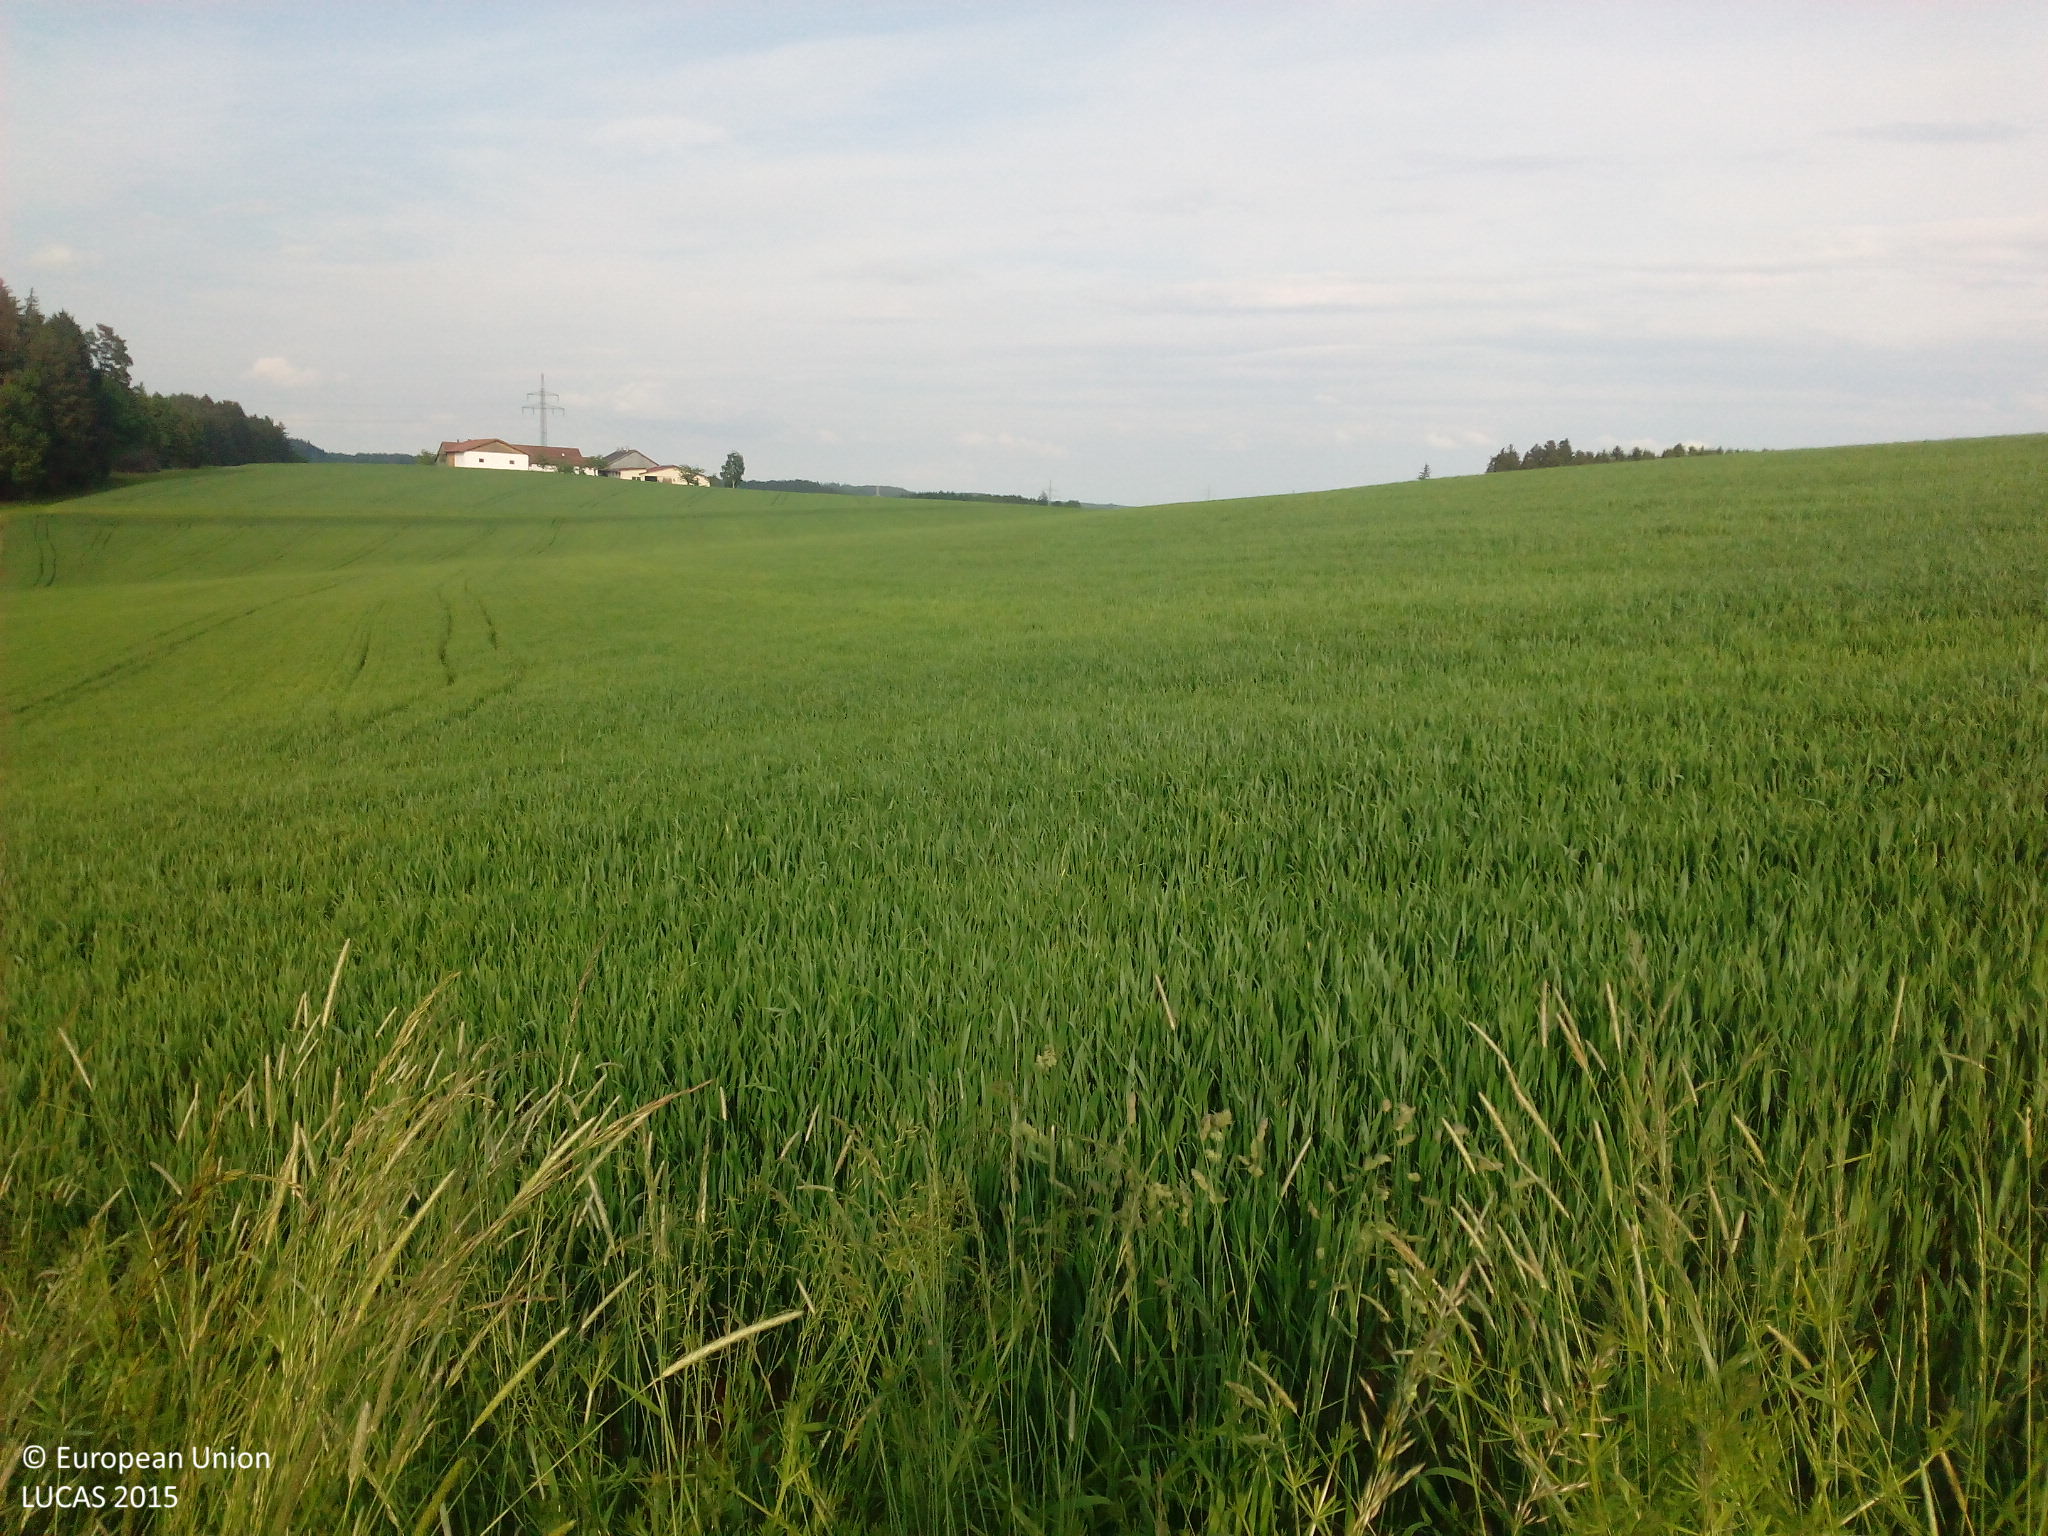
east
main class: Grassland
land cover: Grassland without tree/shrub cover
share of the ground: > 75 %
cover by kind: herbaceous plants 100 %
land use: Road transport
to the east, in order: Grassland without tree/shrub cover; Common wheat
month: May
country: DE
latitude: 48.3597
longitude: 12.3879
